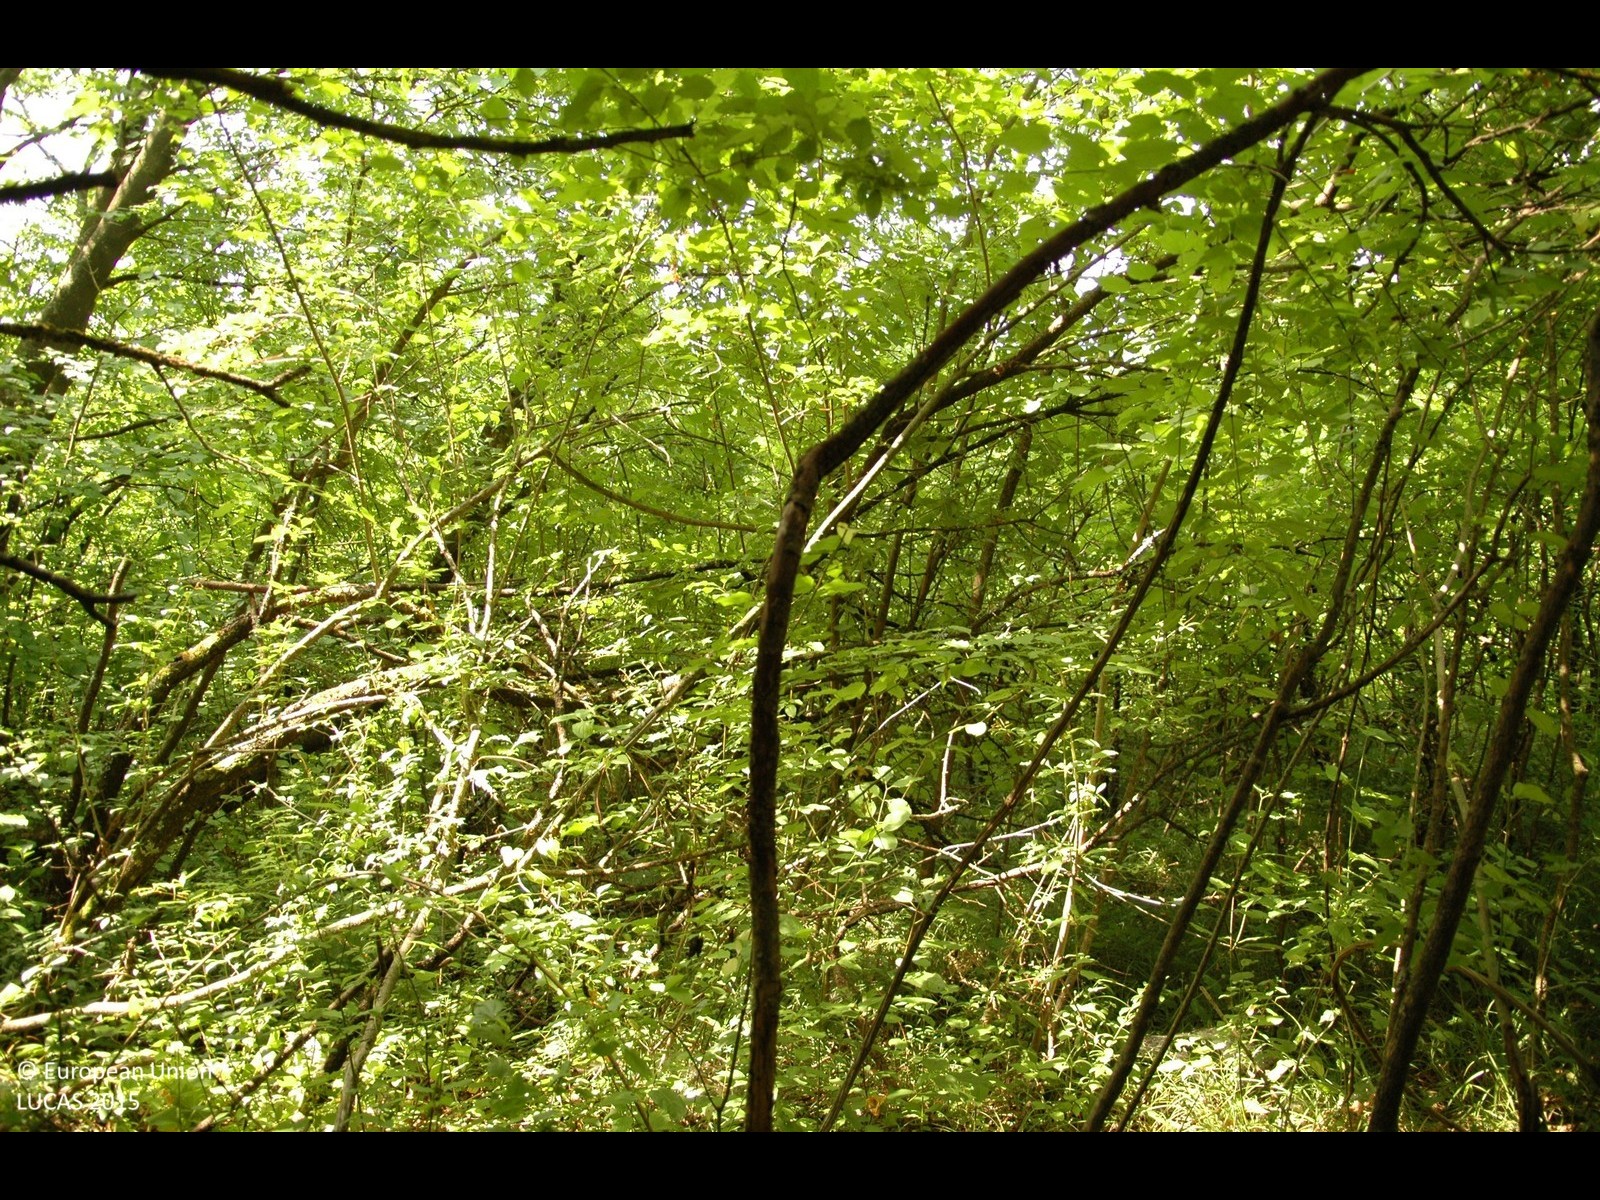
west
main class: Shrubland
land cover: Shrubland without tree cover
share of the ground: > 75 %
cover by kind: shrubs 100 %
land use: Semi-natural and natural areas not in use
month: July
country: HR
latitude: 46.1479
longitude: 16.5904
